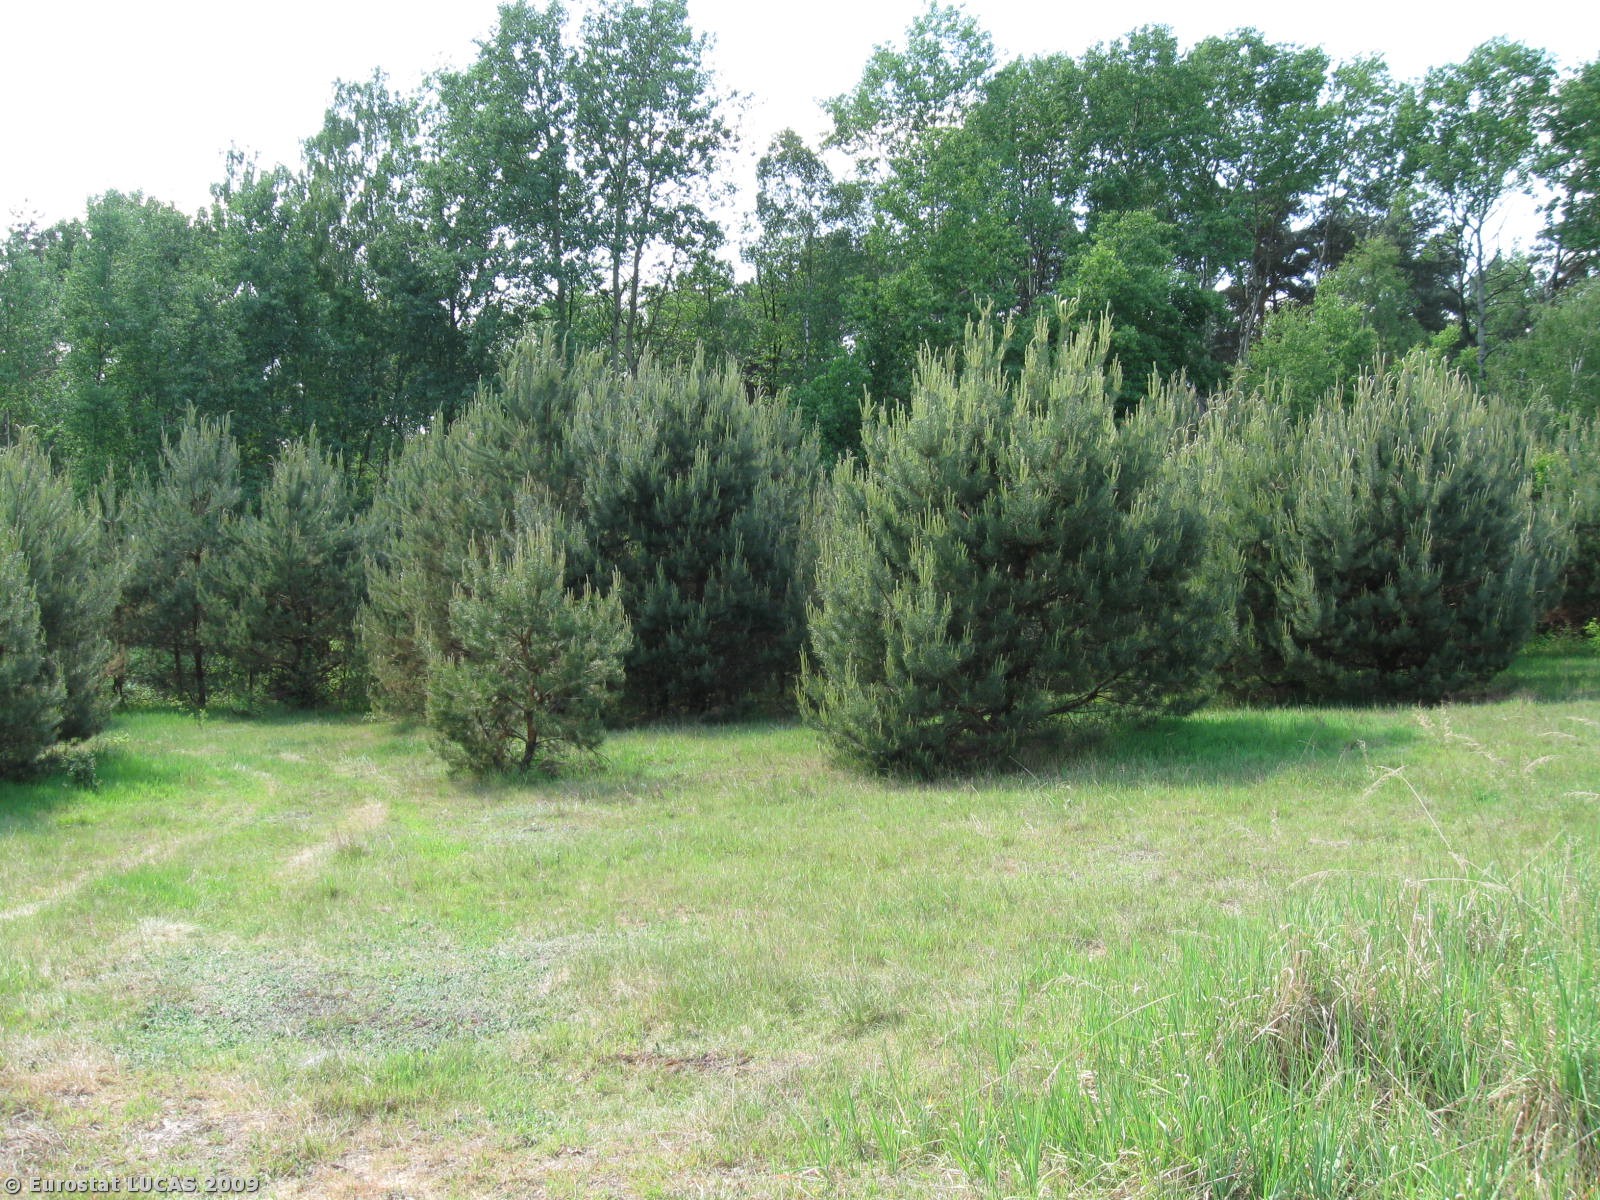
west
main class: Grassland
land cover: Grassland without tree/shrub cover
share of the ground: > 75 %
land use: Unused
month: May
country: PL
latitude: 50.6701
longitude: 20.3800
